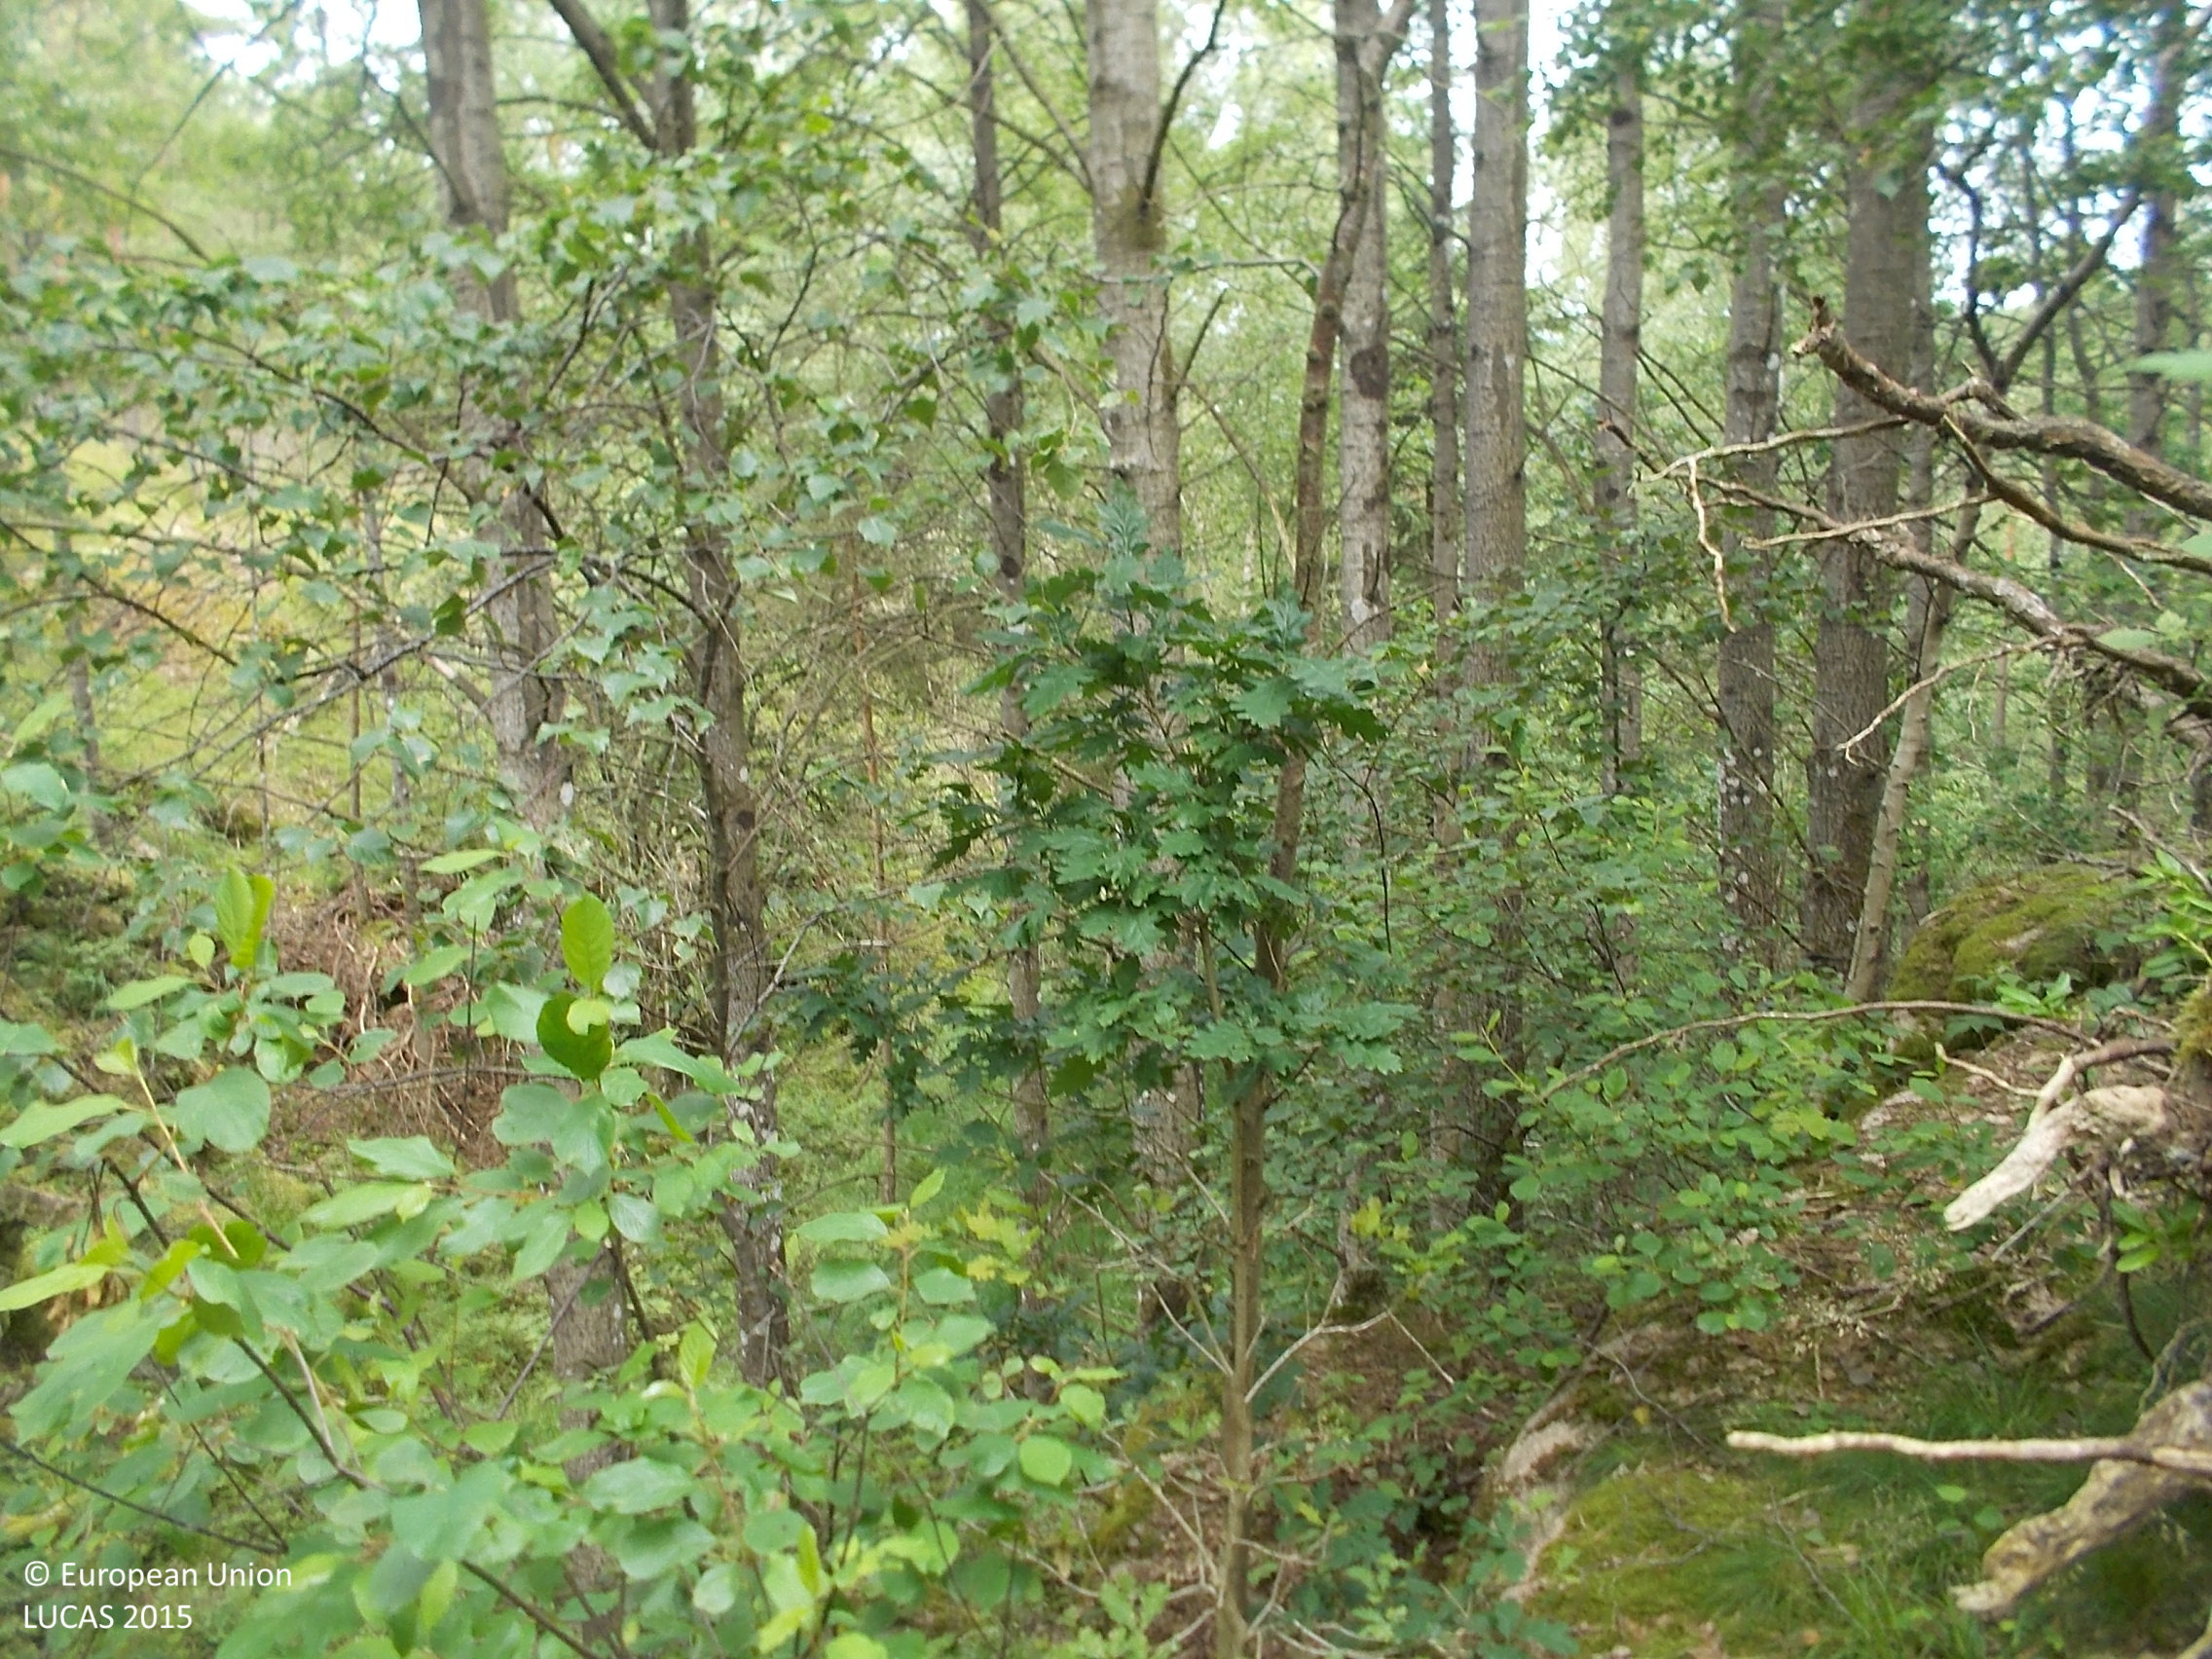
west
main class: Woodland
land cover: Broadleaved woodland
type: hemiboreal forest and nemoral coniferous forest and mixed broadleaved-coniferous forest
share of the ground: > 75 %
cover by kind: broadleaved forest trees 80 %, herbaceous plants 10 %, shrubs 5 %, lichens and mosses 5 %
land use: Forestry
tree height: > 5 m
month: July
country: SE
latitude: 57.2834
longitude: 12.2363
